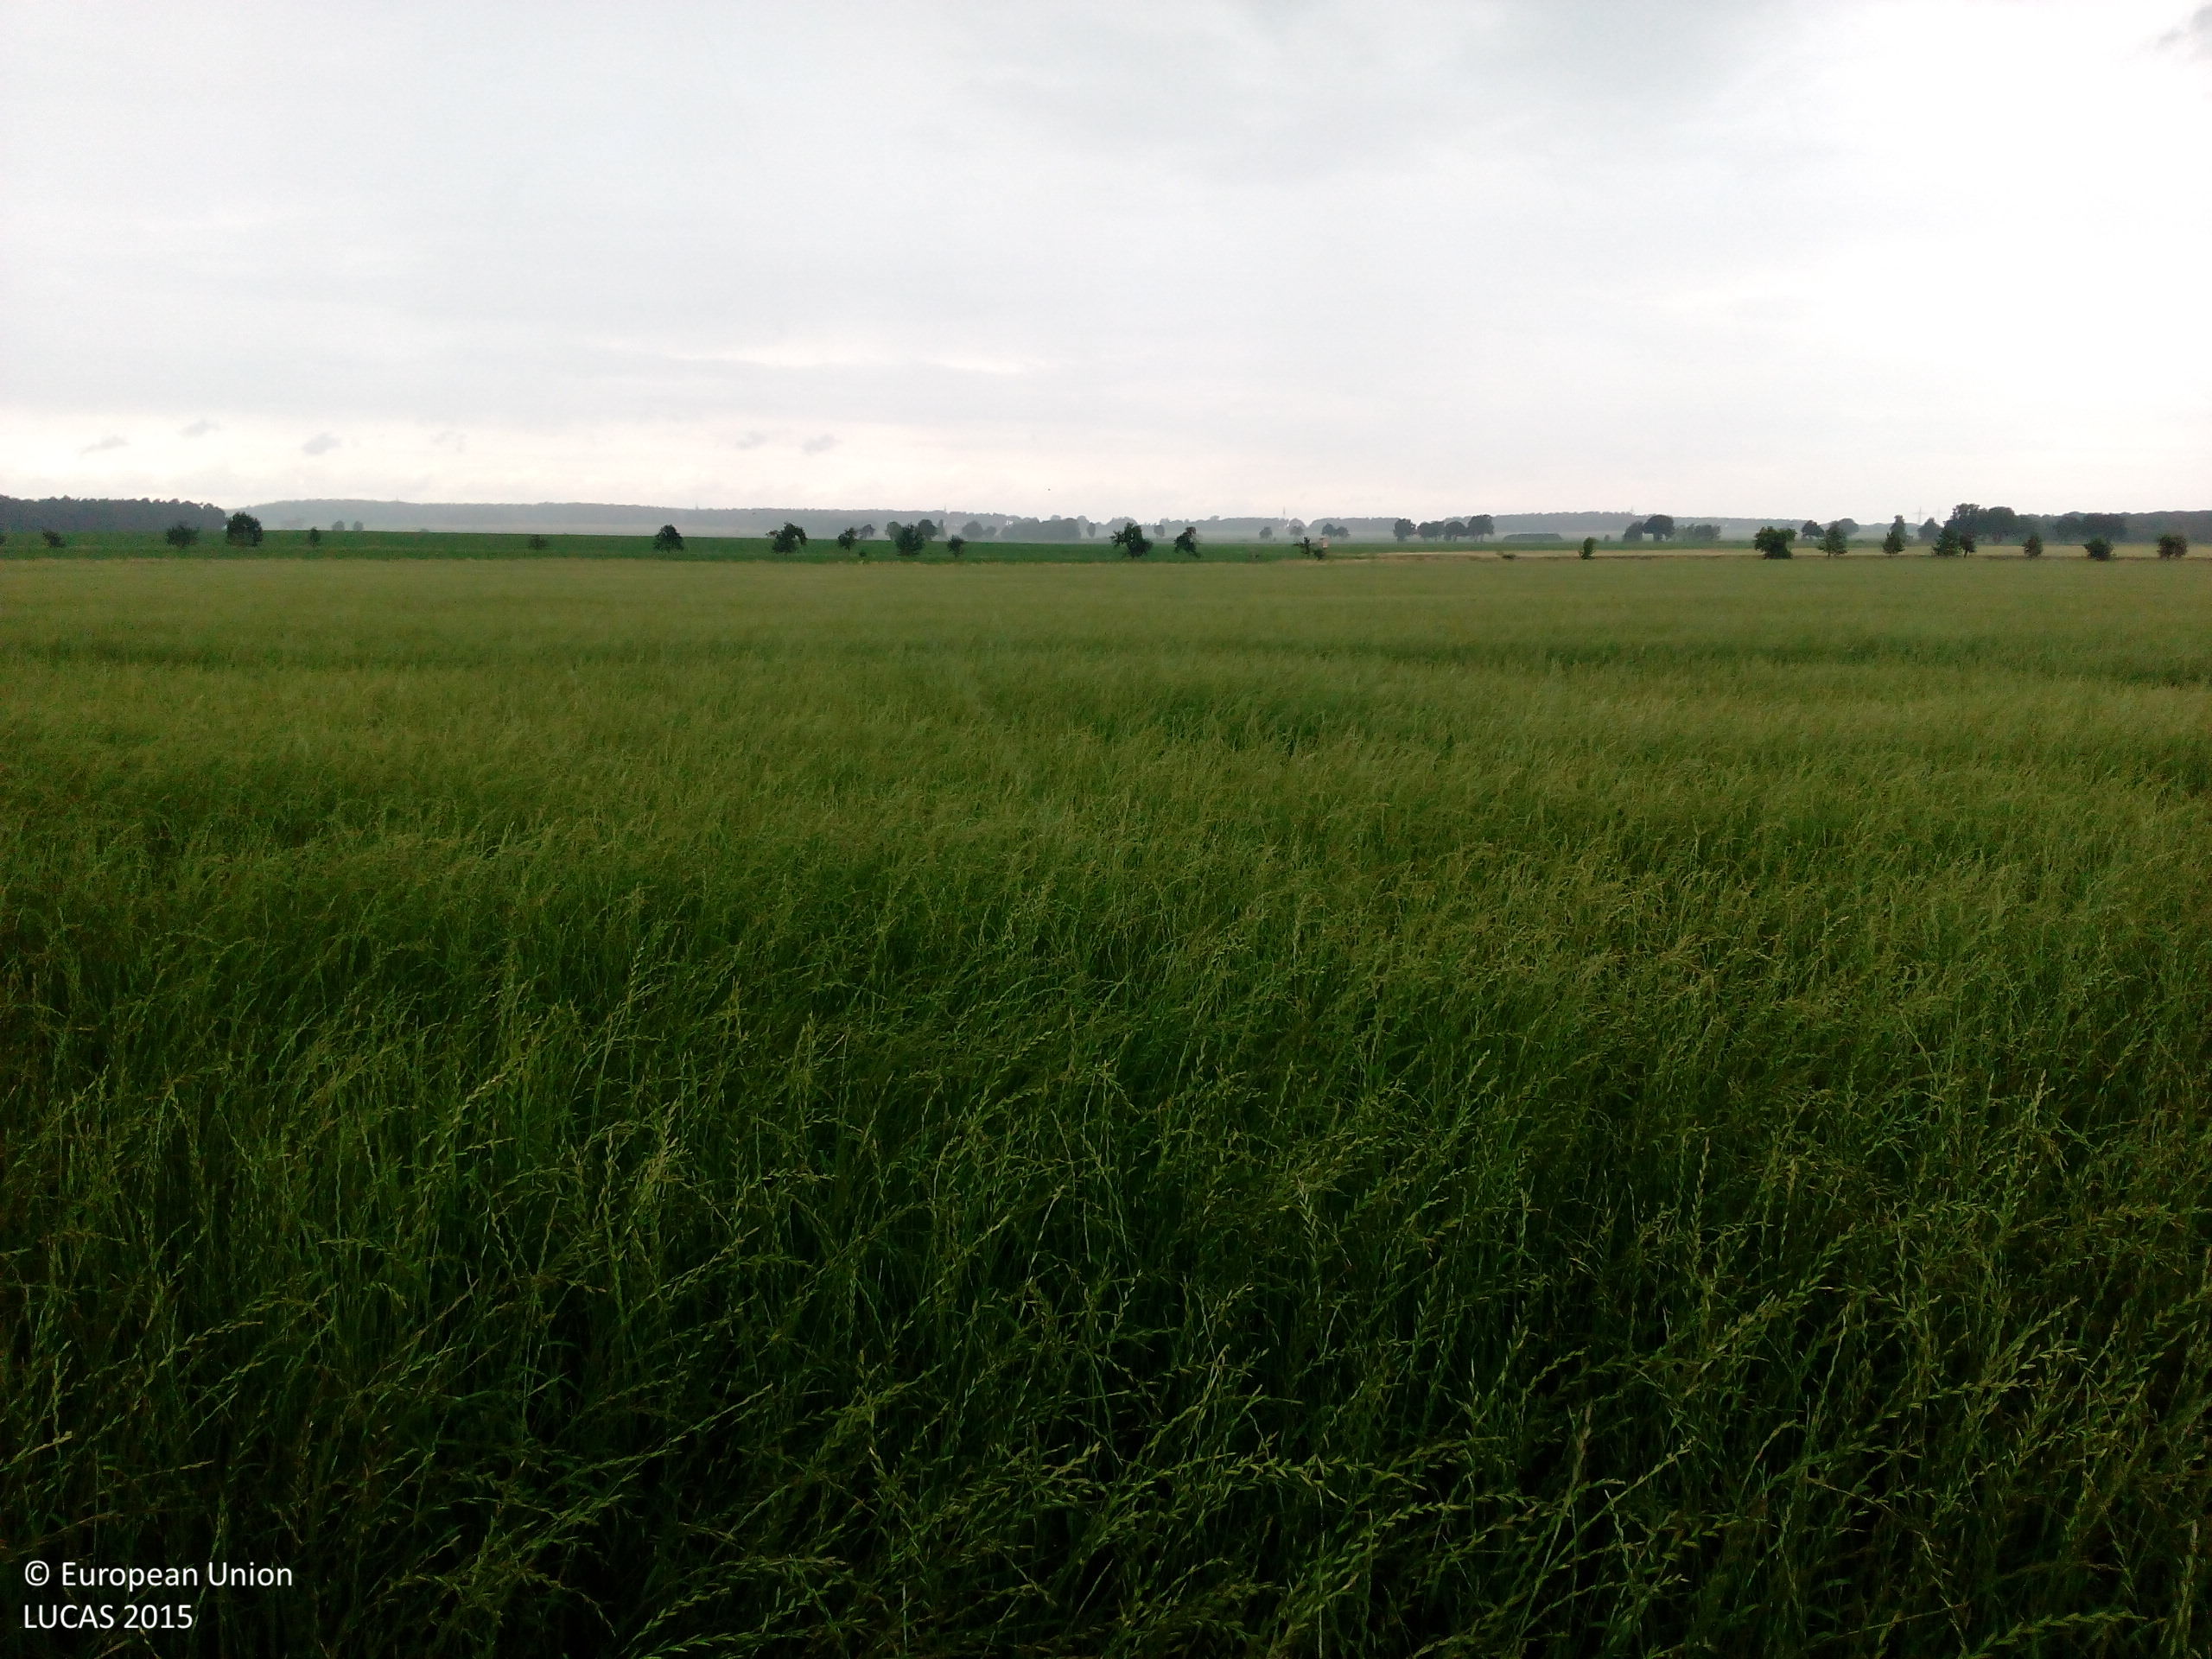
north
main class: Cropland
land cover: Temporary grasslands
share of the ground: > 75 %
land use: Agriculture (excluding fallow land and kitchen gardens)
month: June
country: DE
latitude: 52.3721
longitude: 11.1306
